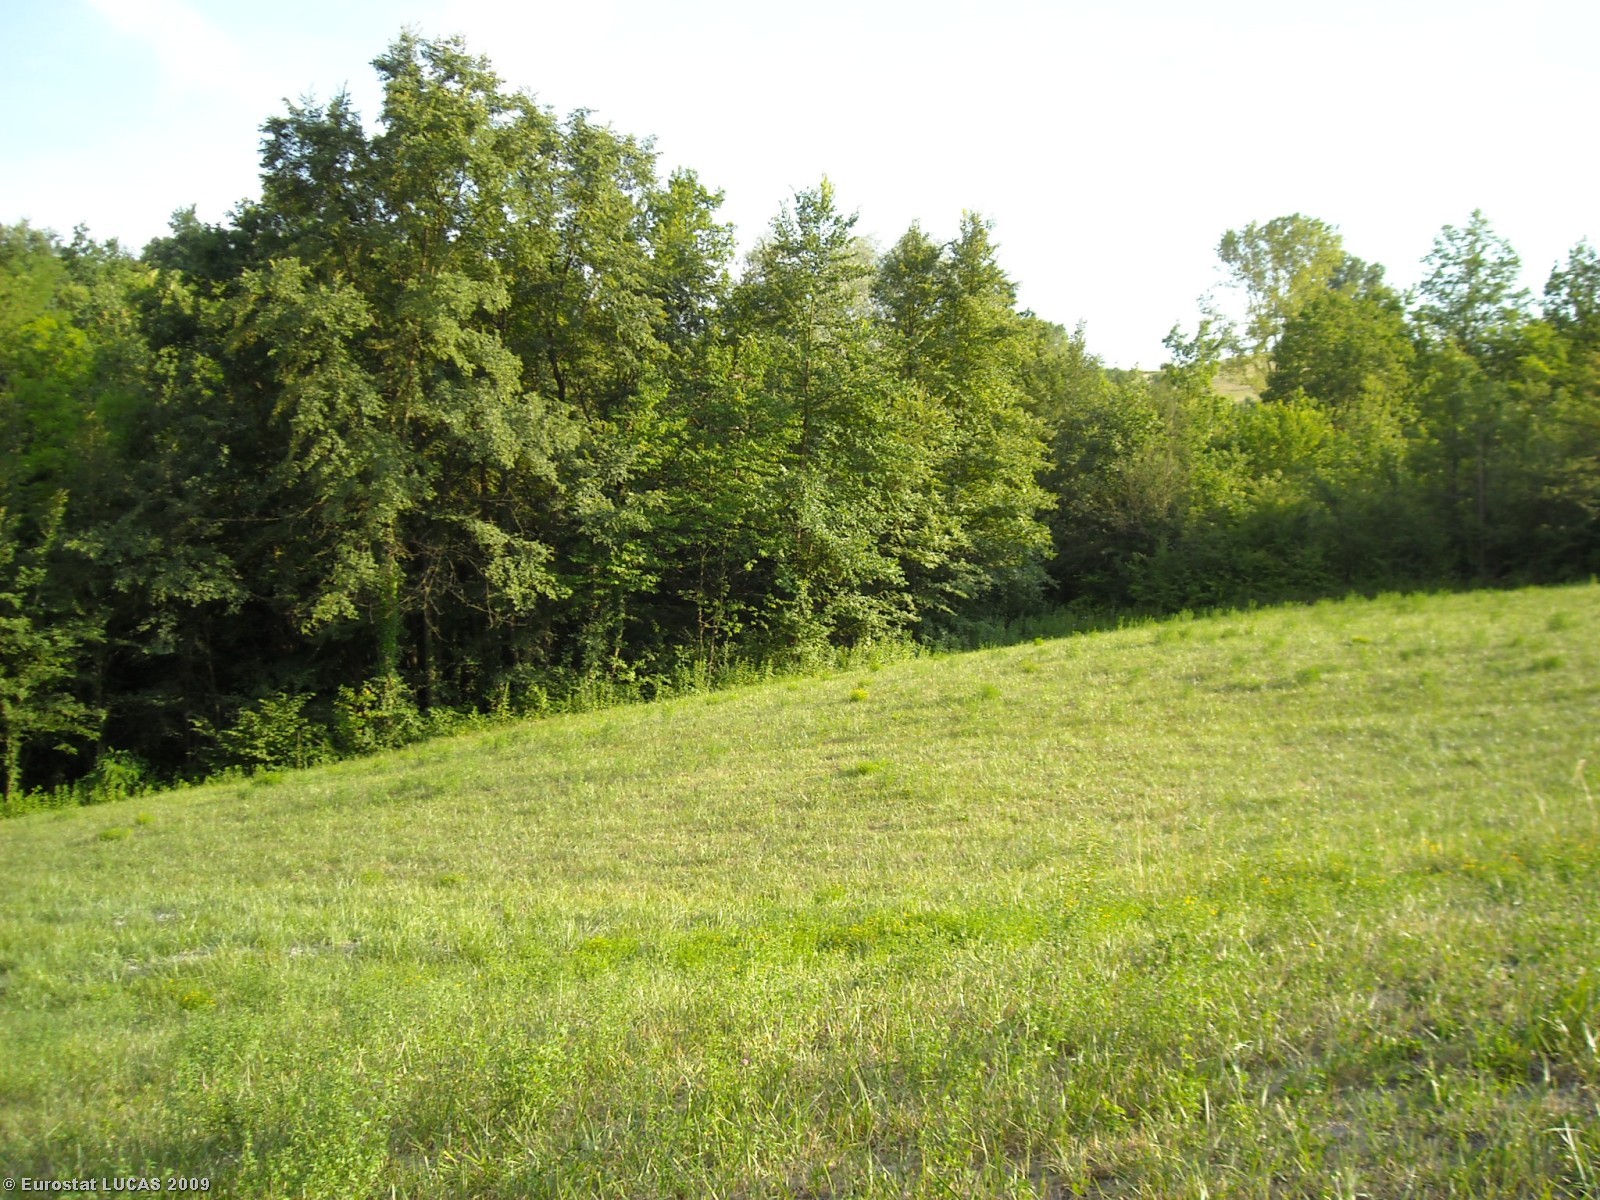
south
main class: Grassland
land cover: Grassland without tree/shrub cover
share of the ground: > 75 %
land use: Agriculture (excluding fallow land and kitchen gardens)
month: June
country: IT
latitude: 45.1264
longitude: 8.0836
